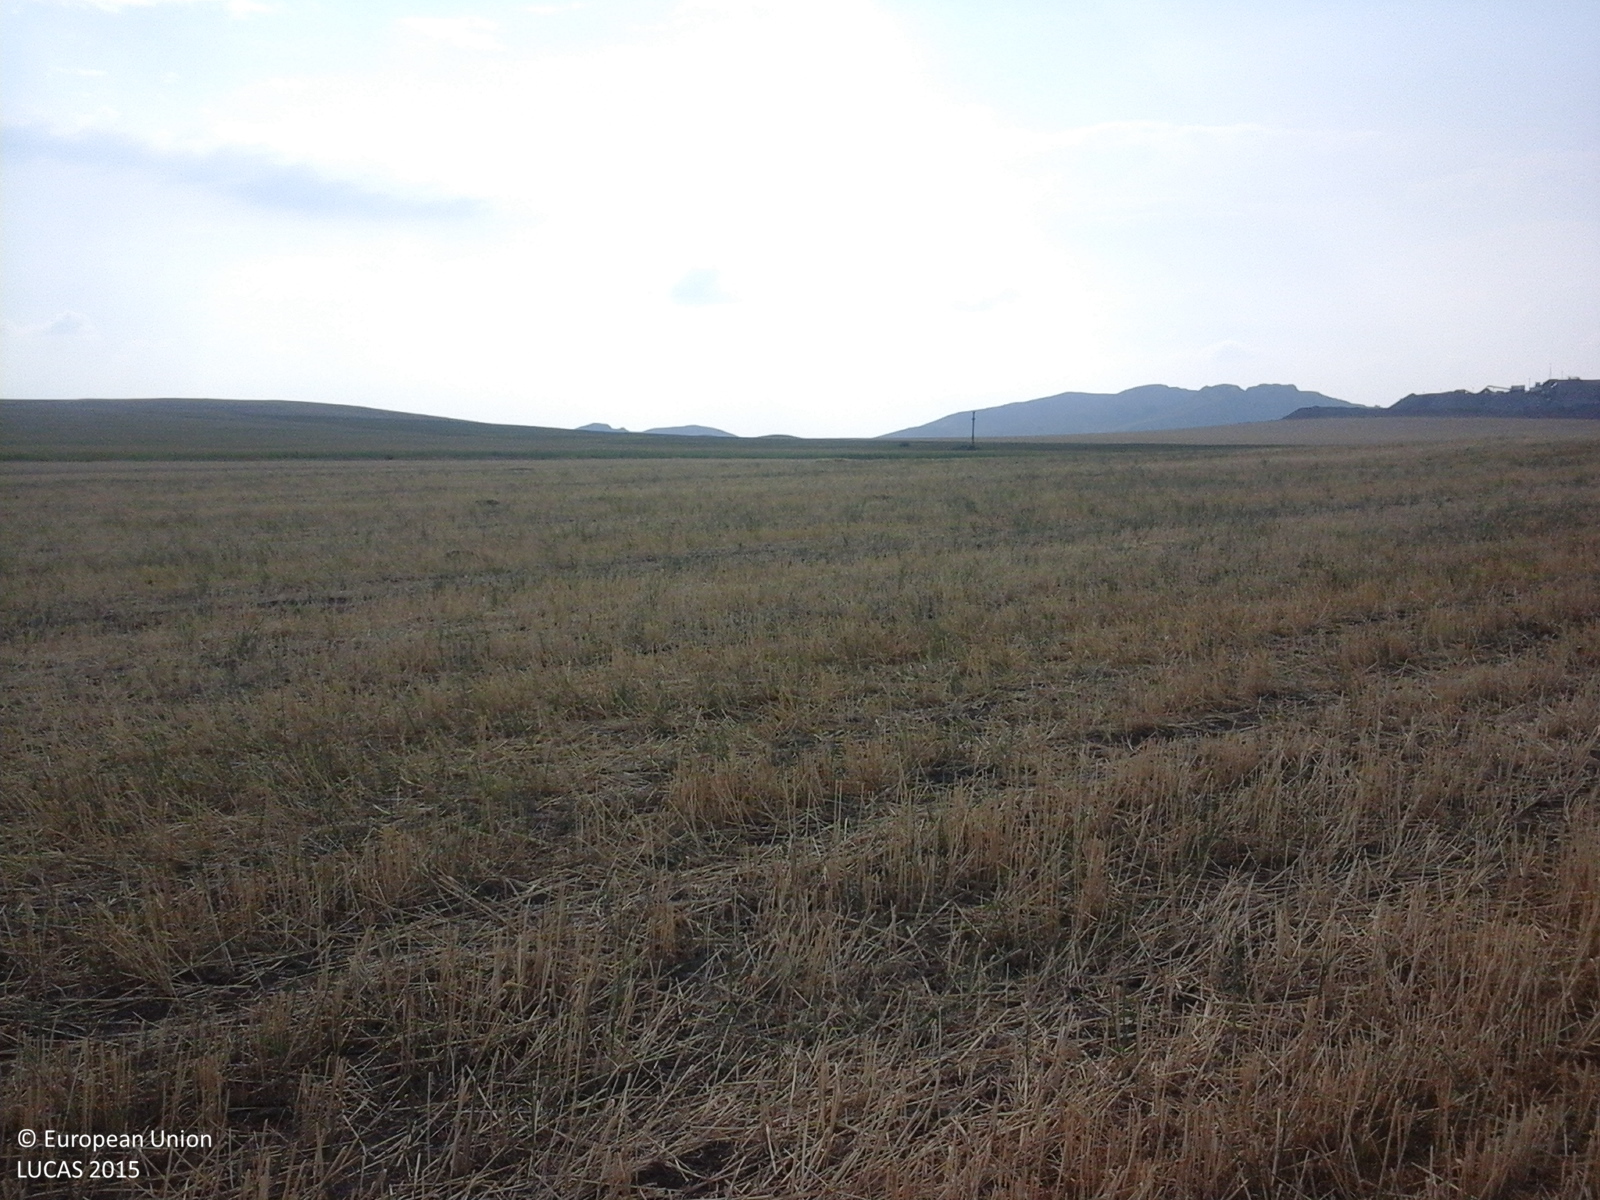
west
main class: Cropland
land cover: Common wheat
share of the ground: > 75 %
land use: Agriculture (excluding fallow land and kitchen gardens)
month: July
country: RO
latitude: 45.0950
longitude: 28.2545
